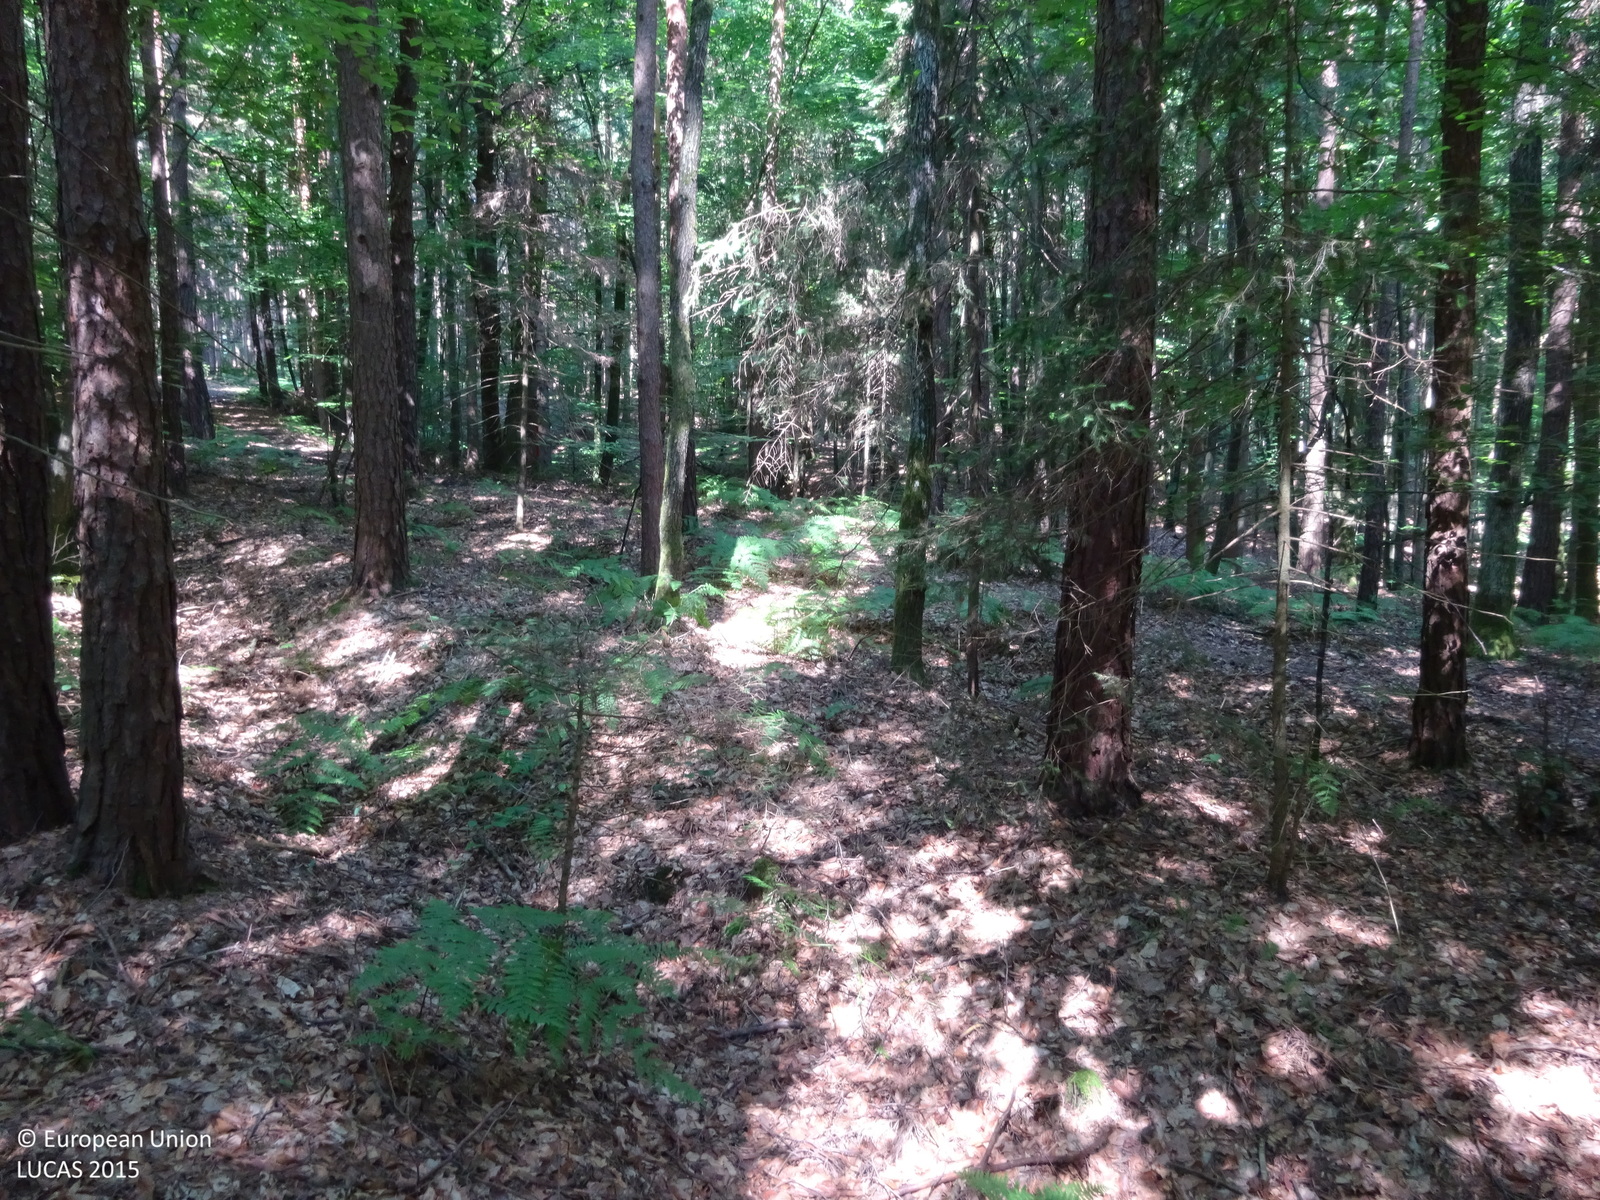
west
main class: Woodland
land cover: Pine dominated mixed woodland
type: hemiboreal forest and nemoral coniferous forest and mixed broadleaved-coniferous forest
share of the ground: > 75 %
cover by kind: broadleaved forest trees 65 %, coniferous forest trees 35 %
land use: Forestry
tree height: > 5 m
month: July
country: AT
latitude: 46.9171
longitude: 16.1070
